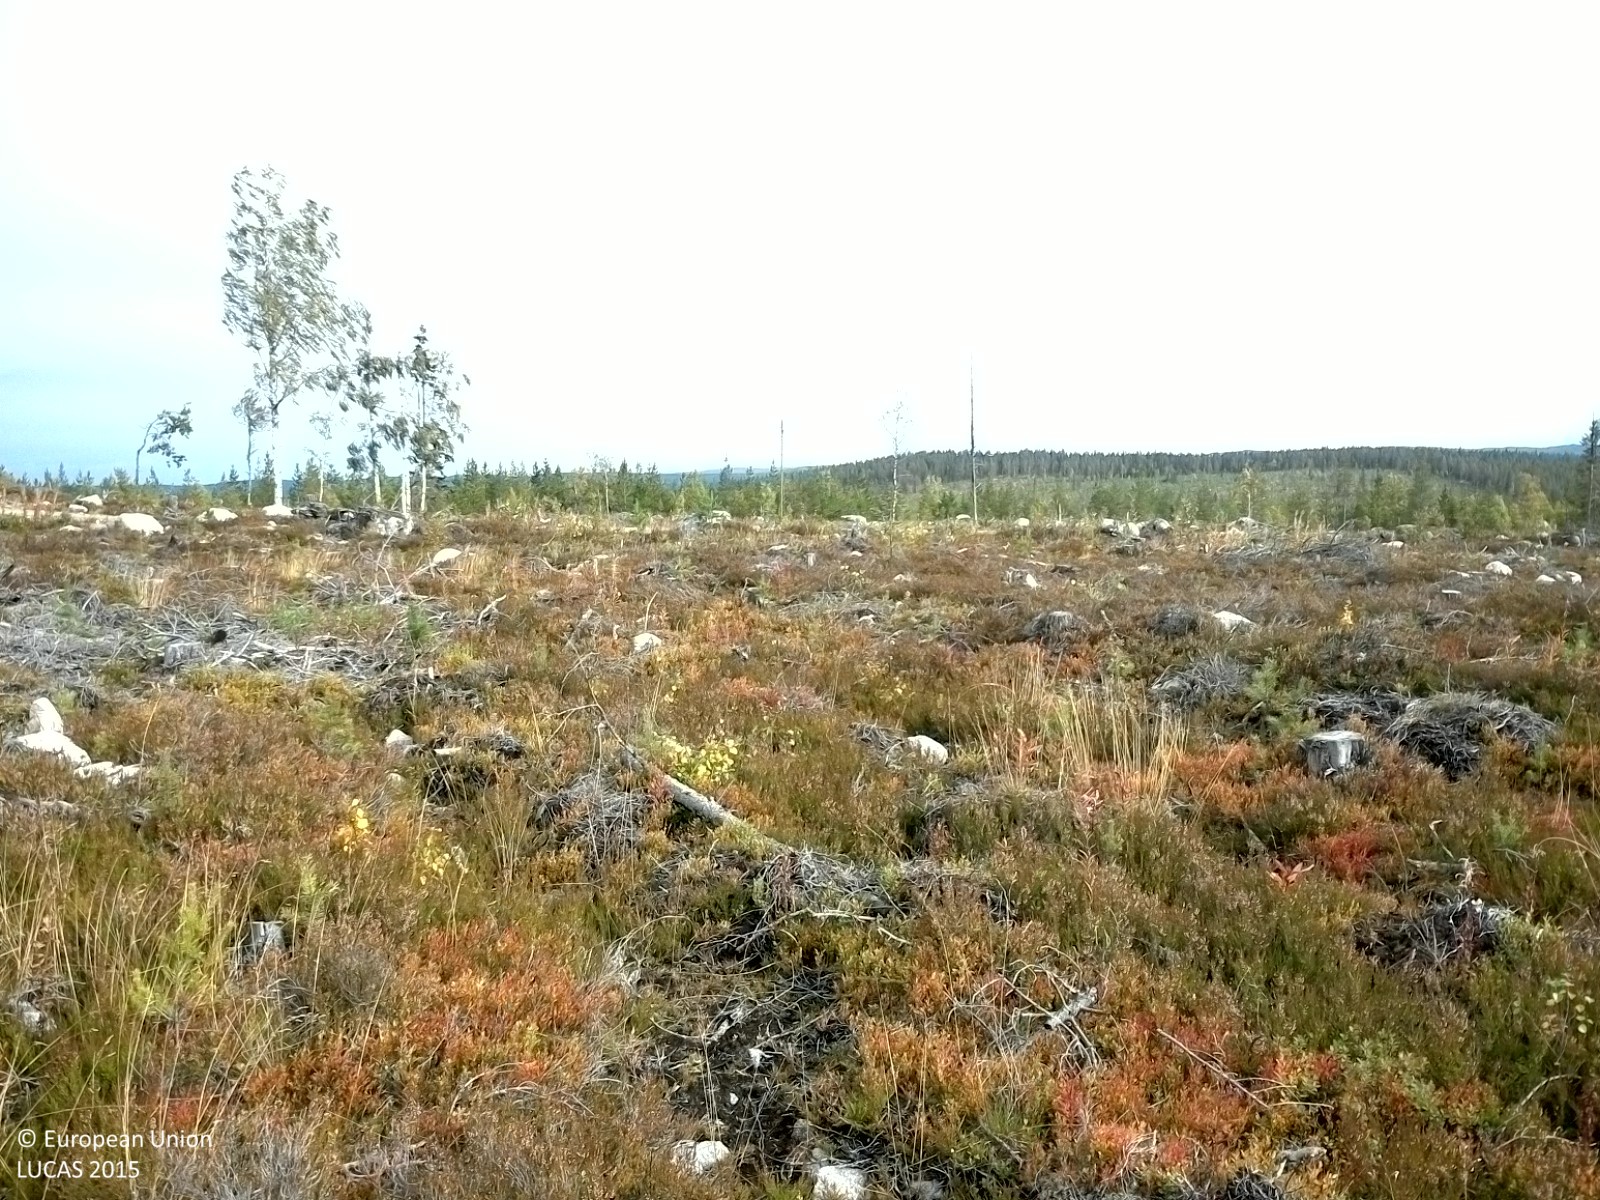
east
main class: Shrubland
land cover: Shrubland with sparse tree cover
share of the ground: > 75 %
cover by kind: shrubs 70 %, unconsolidated bare surface 15 %, coniferous forest trees 5 %
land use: Forestry
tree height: < 5 m
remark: Clear cut
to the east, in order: Shrubland with sparse tree cover; Broadleaved woodland; Paved roads, cycling and walking lanes; Shrubland with sparse tree cover; Pine dominated mixed woodland; Pine dominated coniferous woodland
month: September
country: SE
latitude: 62.3110
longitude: 15.5555
